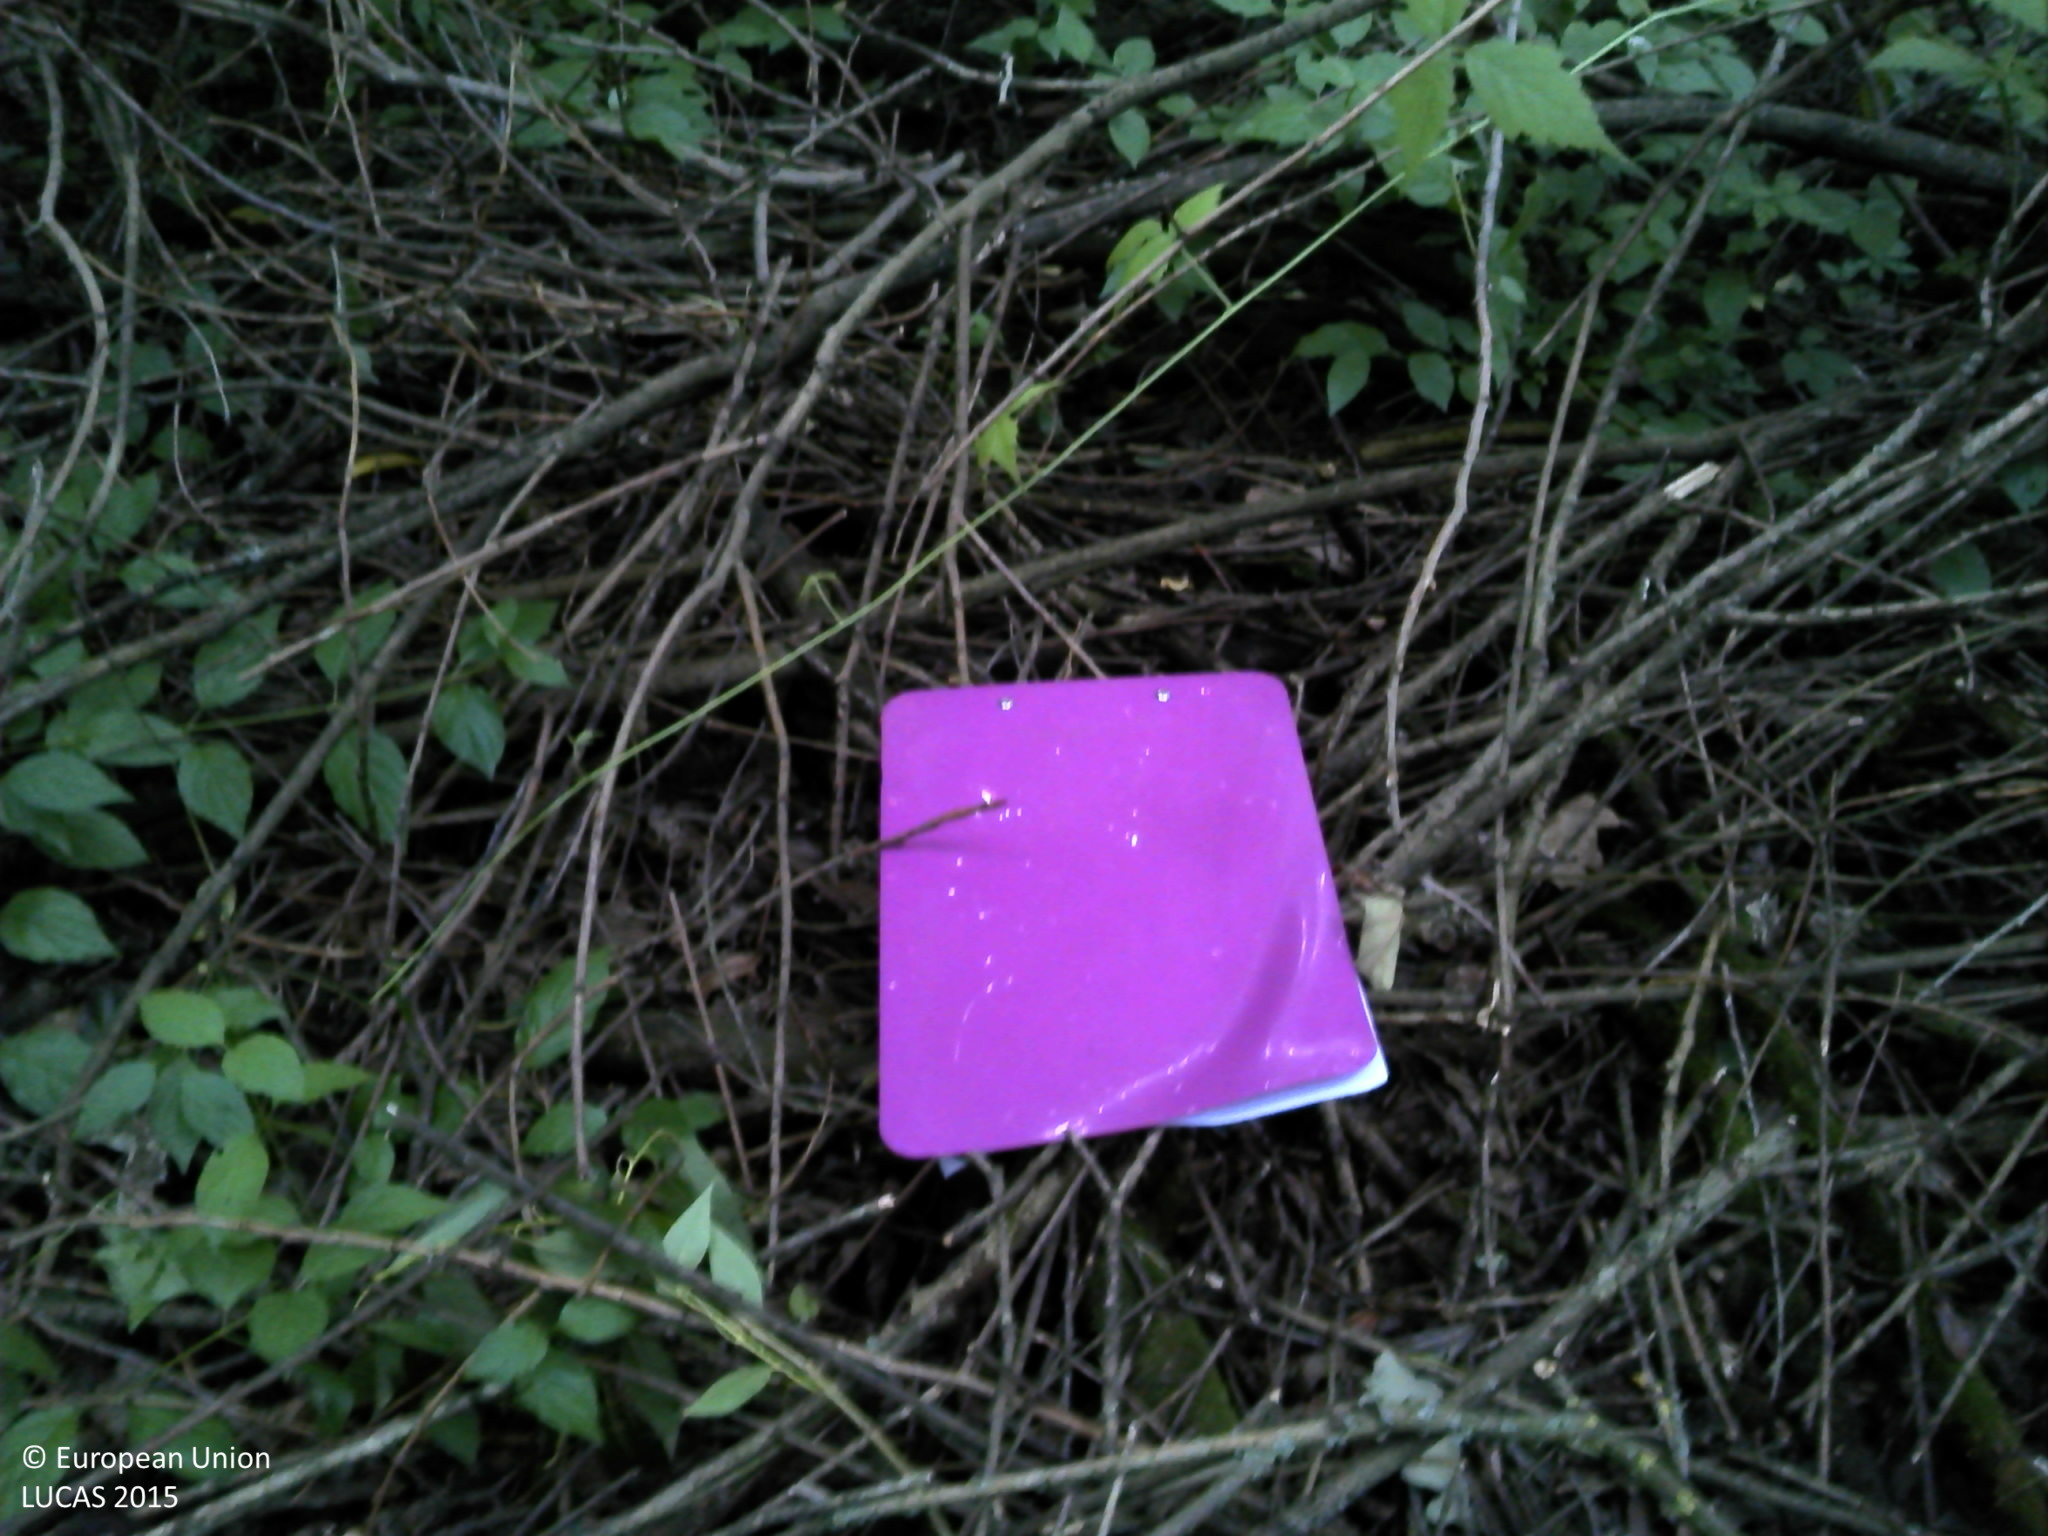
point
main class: Woodland
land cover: Broadleaved woodland
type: mesophytic deciduous forest
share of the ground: > 75 %
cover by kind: broadleaved forest trees 100 %
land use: Semi-natural and natural areas not in use
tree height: > 5 m
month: June
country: HR
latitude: 45.4364
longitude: 18.4556
